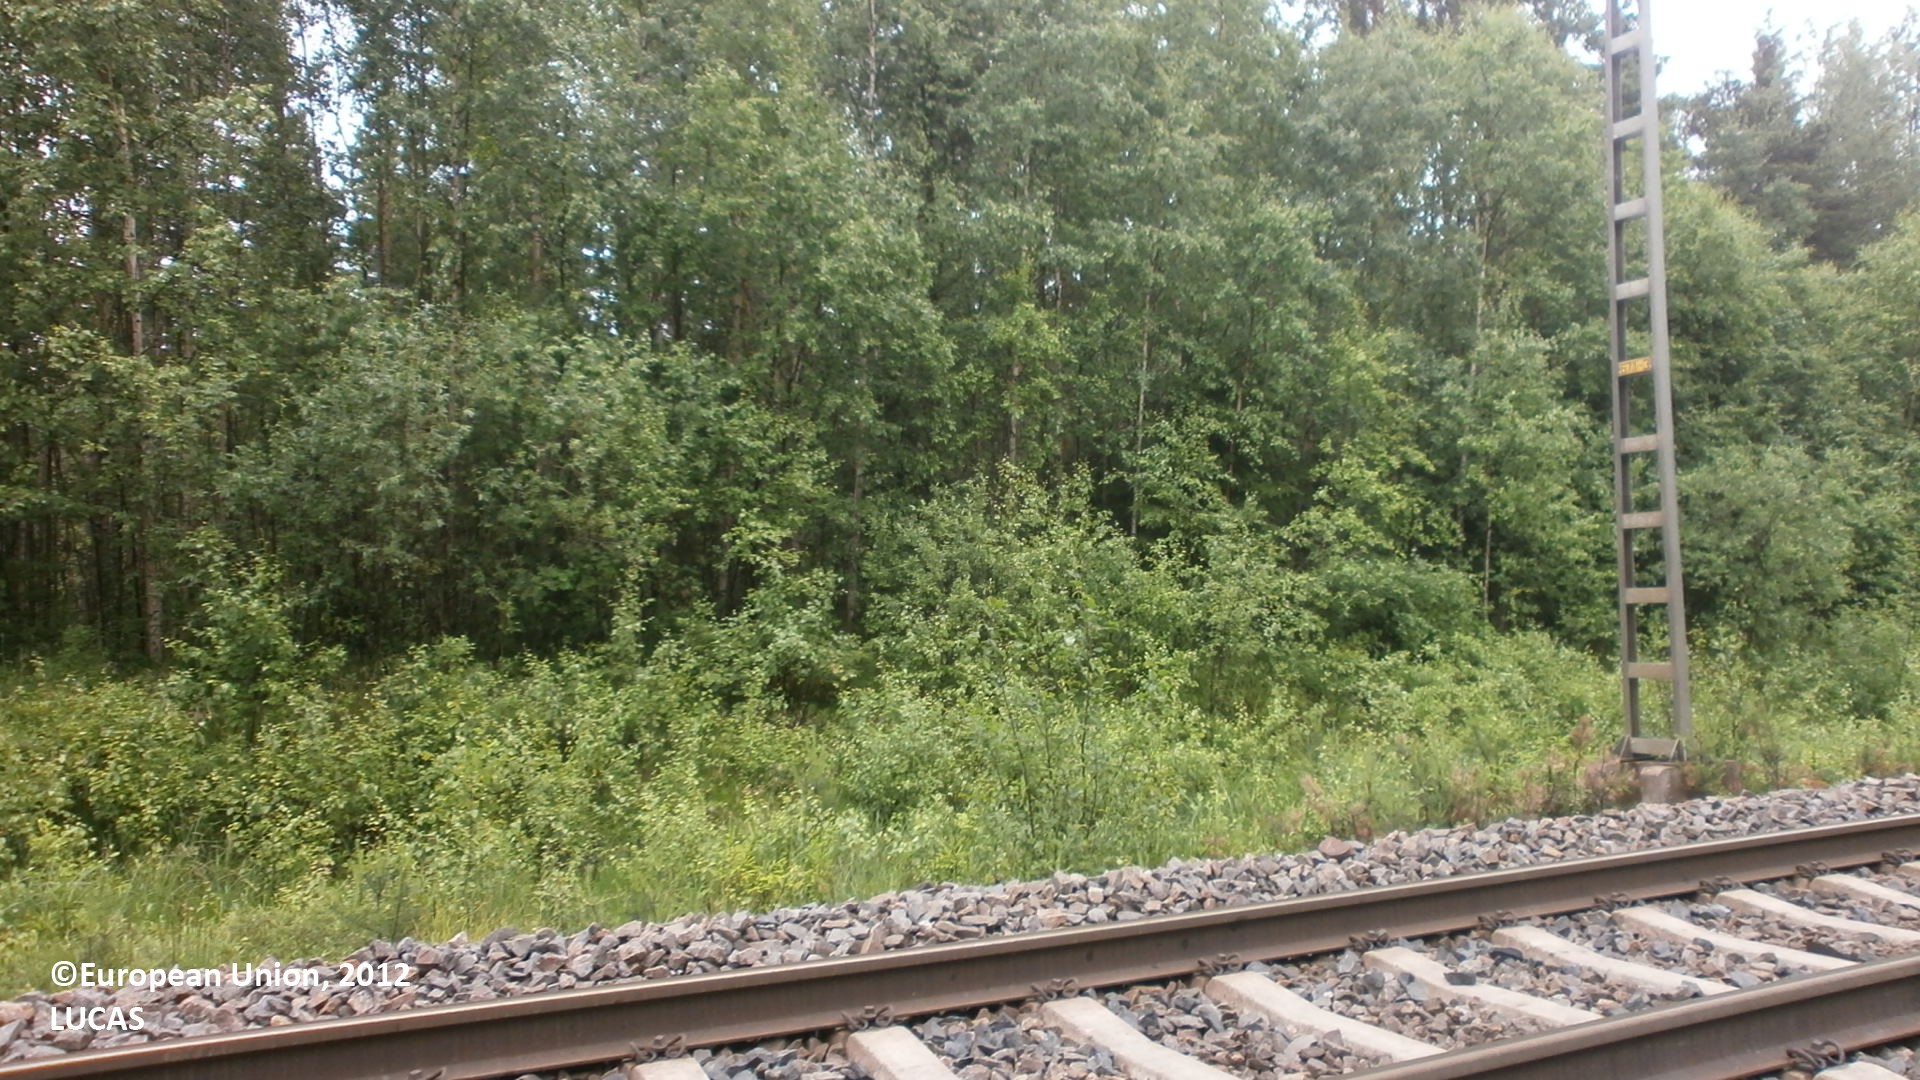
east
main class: Artificial land
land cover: Non built-up linear features
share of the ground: 50 - 75 %
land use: Railway transport
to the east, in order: Broadleaved woodland; Railways; Broadleaved woodland; Ditches and canals; Broadleaved woodland; Pine dominated coniferous woodland; Ditches and canals; Pine dominated coniferous woodland; Ditches and canals; Pine dominated coniferous woodland; Ditches and canals; Spruce dominated coniferous woodland
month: July
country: FI
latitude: 64.3648
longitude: 24.9751
